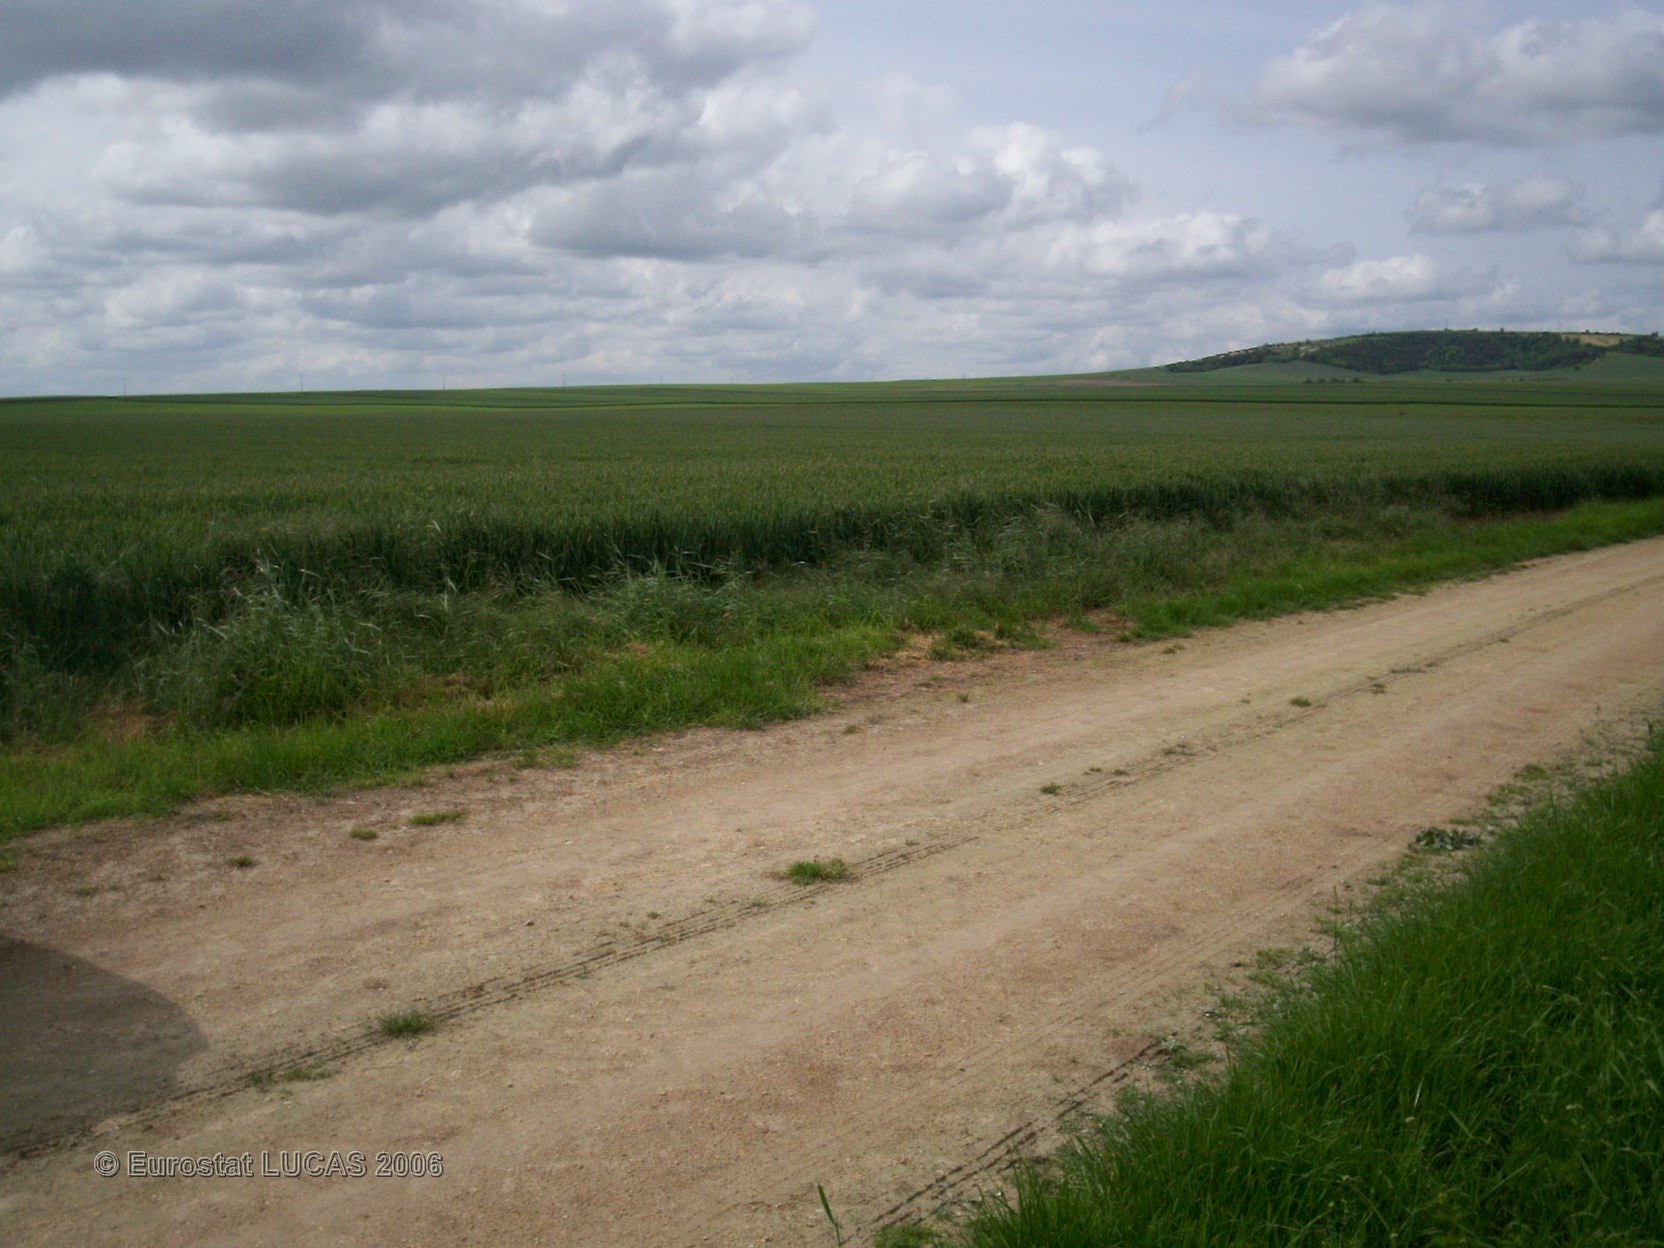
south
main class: Cropland
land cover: Rape and turnip rape
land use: Agriculture (excluding fallow land and kitchen gardens)
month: April
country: FR
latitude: 48.3304
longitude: 3.9935
